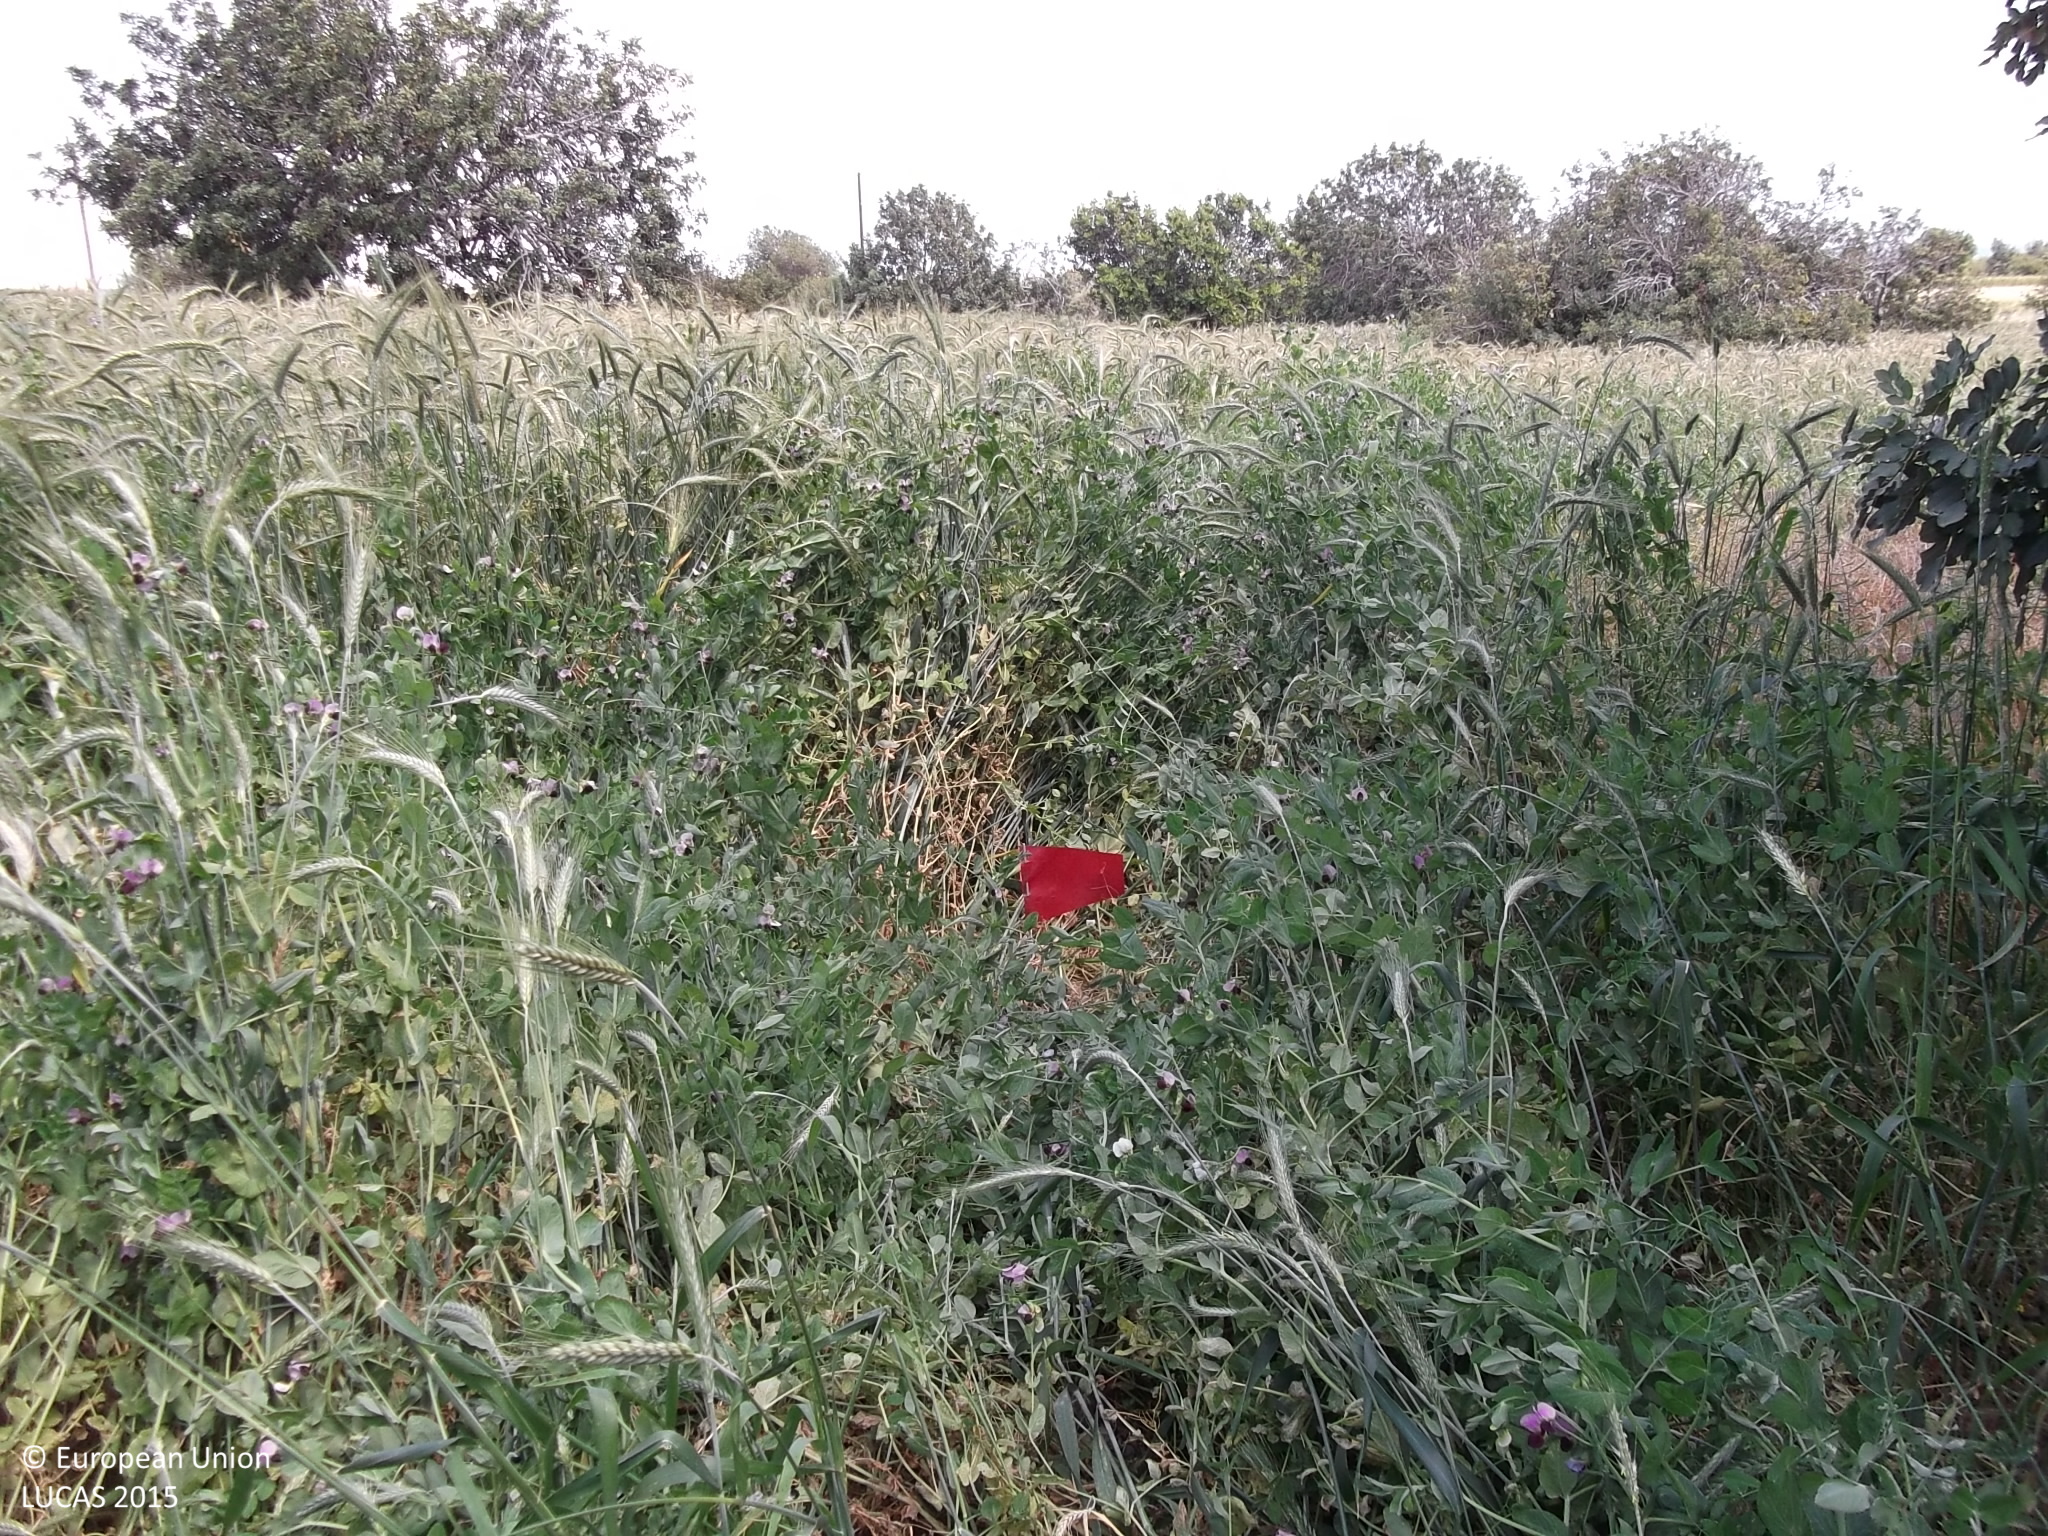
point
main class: Cropland
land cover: Permanent industrial crops
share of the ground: 25 - 50 %
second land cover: Common wheat
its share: > 75 %
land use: Agriculture (excluding fallow land and kitchen gardens)
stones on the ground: 25 - 50 %
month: April
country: CY
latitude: 34.8015
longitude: 33.4790
